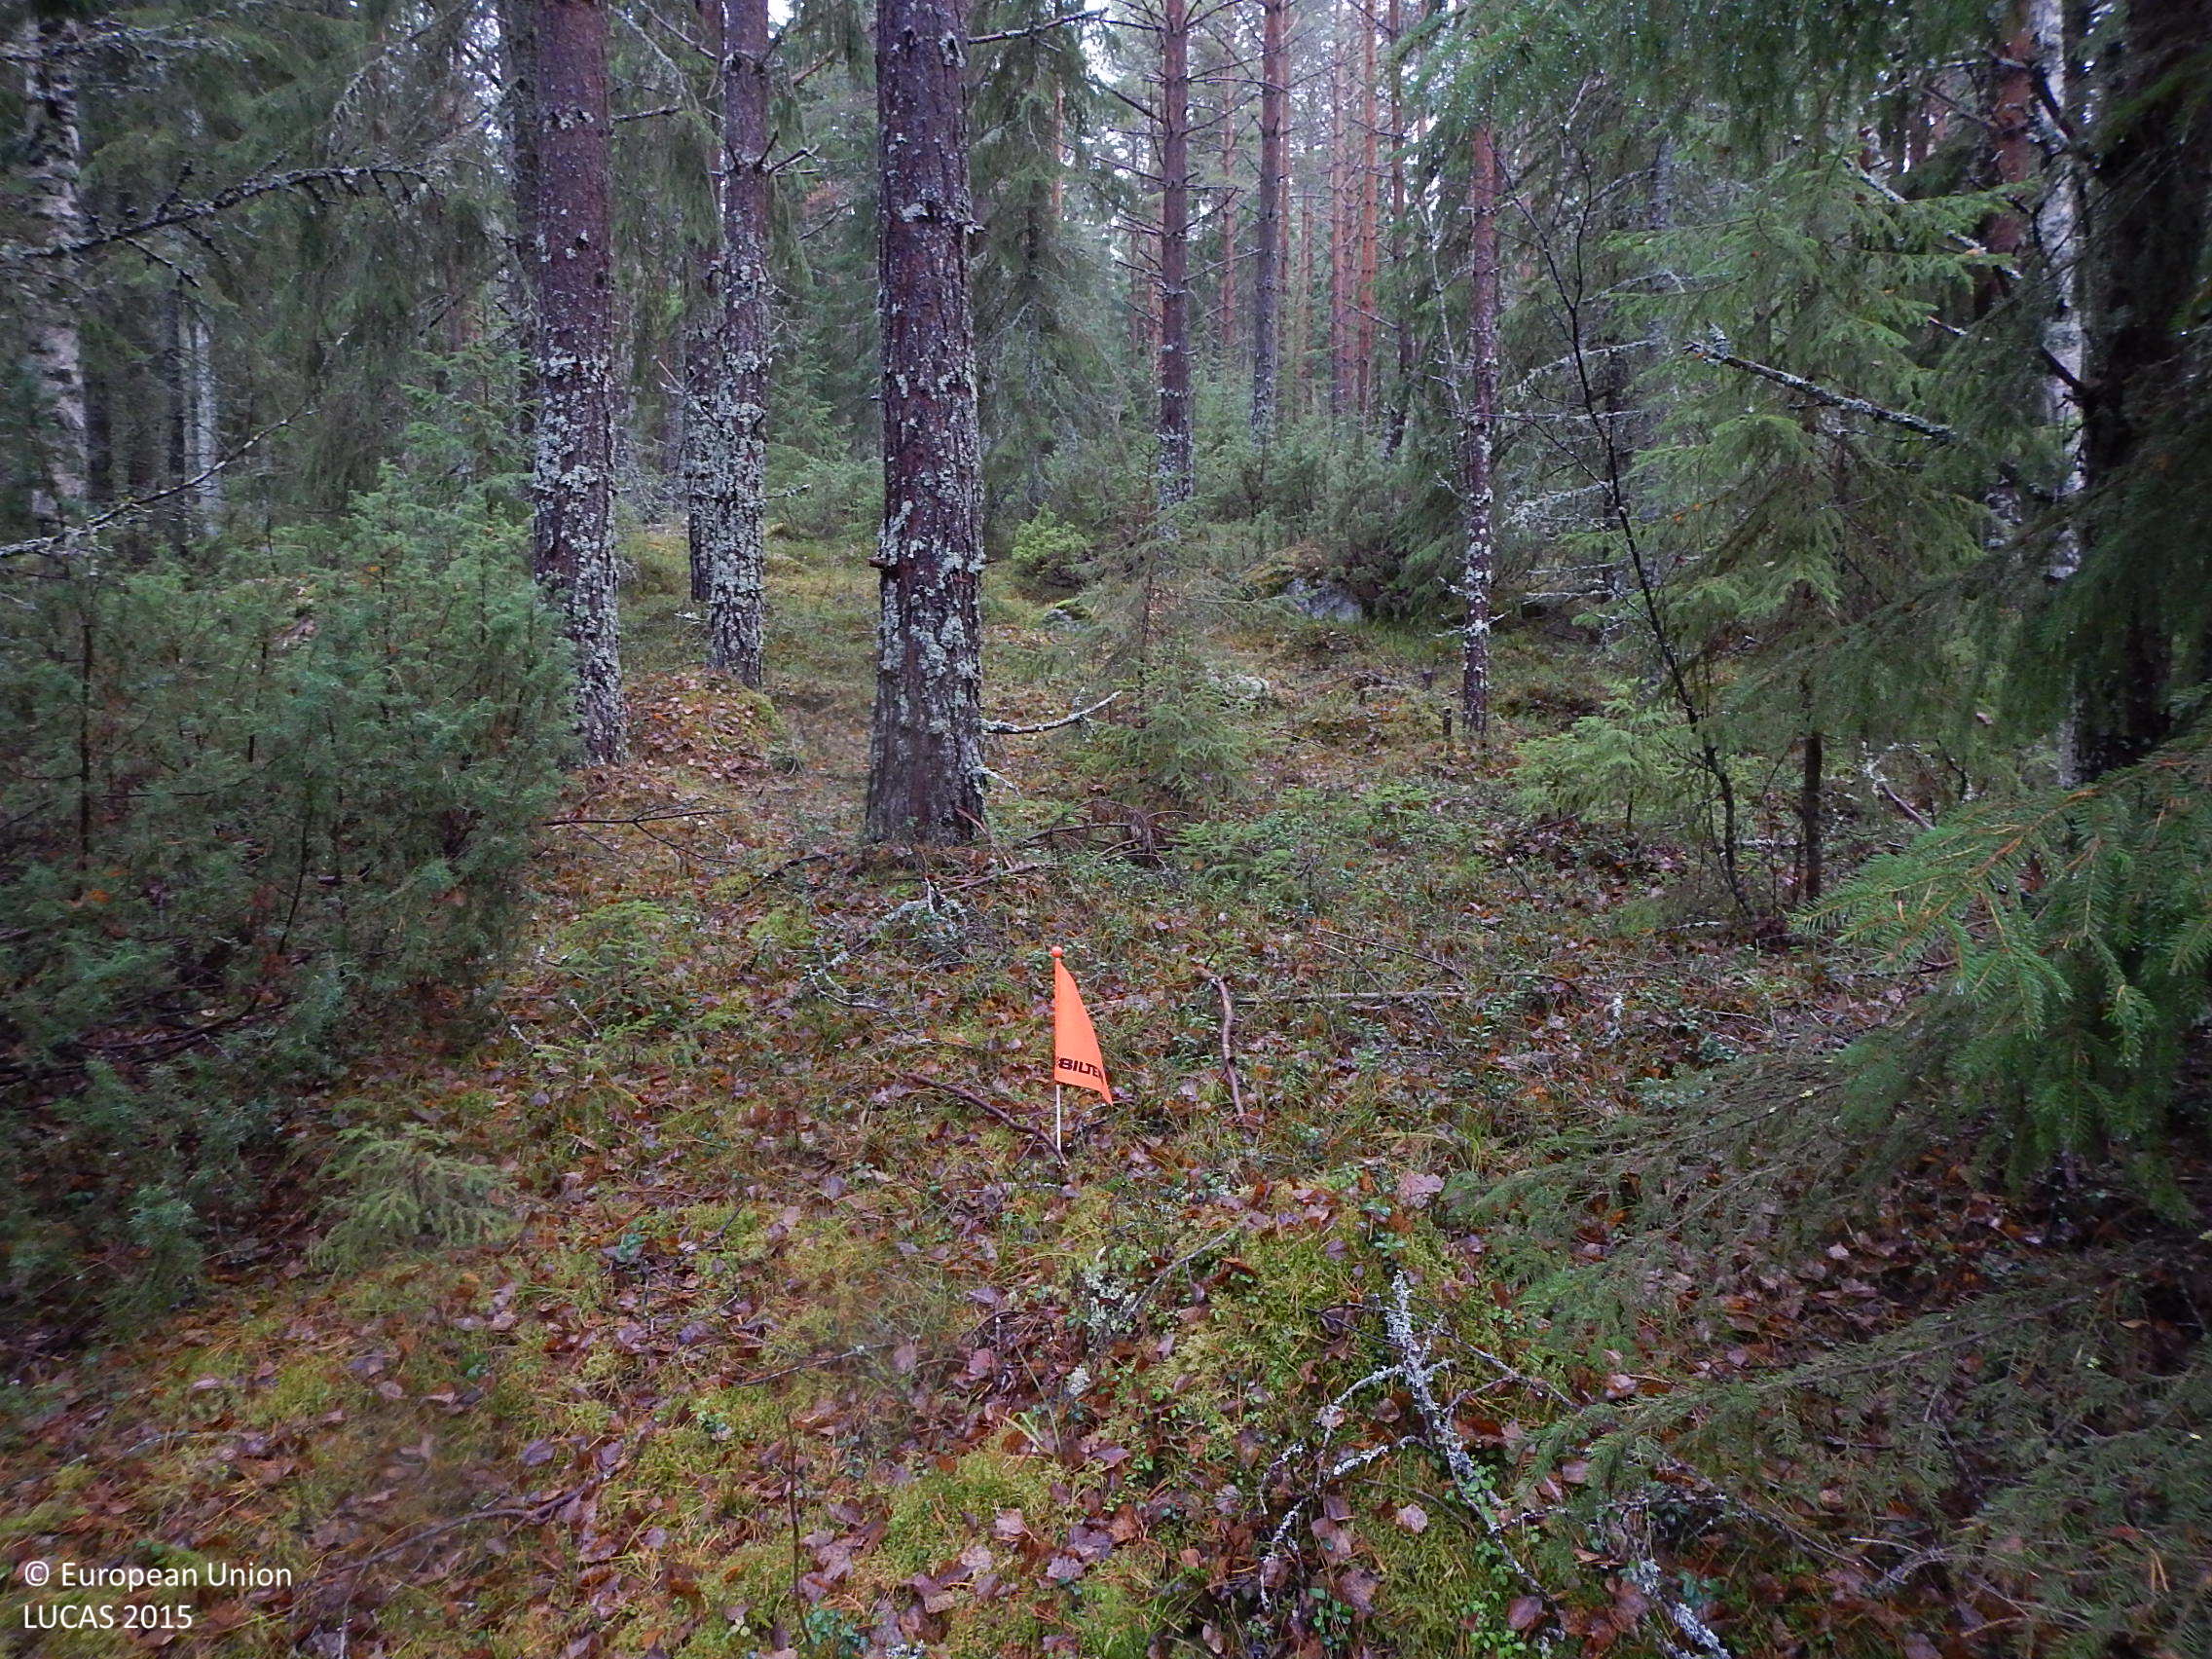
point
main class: Woodland
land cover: Other mixed woodland
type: boreal forest
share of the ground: > 75 %
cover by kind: coniferous forest trees 45 %, broadleaved forest trees 30 %, shrubs 10 %, lichens and mosses 10 %, herbaceous plants 5 %
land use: Forestry
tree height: > 5 m
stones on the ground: < 10 %
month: November
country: SE
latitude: 61.3774
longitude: 16.7029
